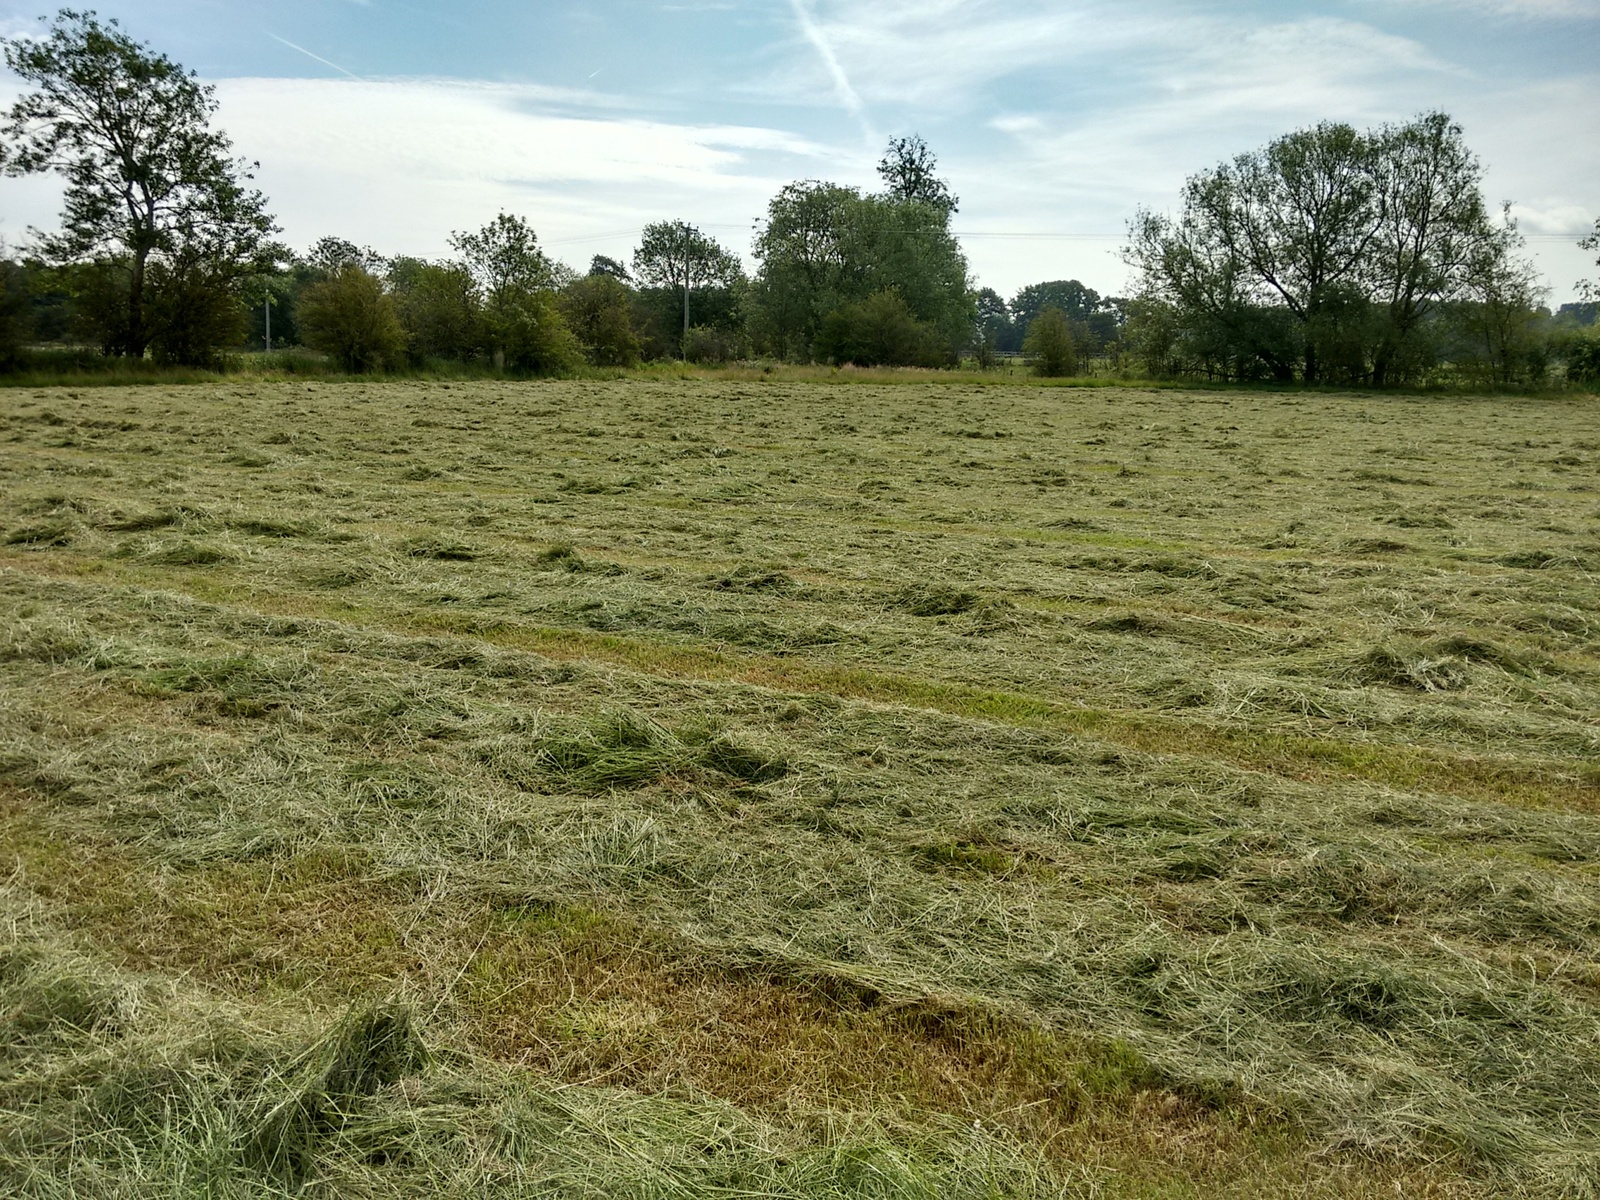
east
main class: Grassland
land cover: Grassland without tree/shrub cover
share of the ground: > 75 %
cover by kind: herbaceous plants 100 %
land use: Agriculture (excluding fallow land and kitchen gardens)
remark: Harvested field
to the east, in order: Grassland without tree/shrub cover; Electric lines; Fences; Managed hedges; Broadleaved woodland; Managed hedges; Grassland without tree/shrub cover; Single bushes/trees
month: June
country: GB
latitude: 51.5609
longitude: -1.1389
